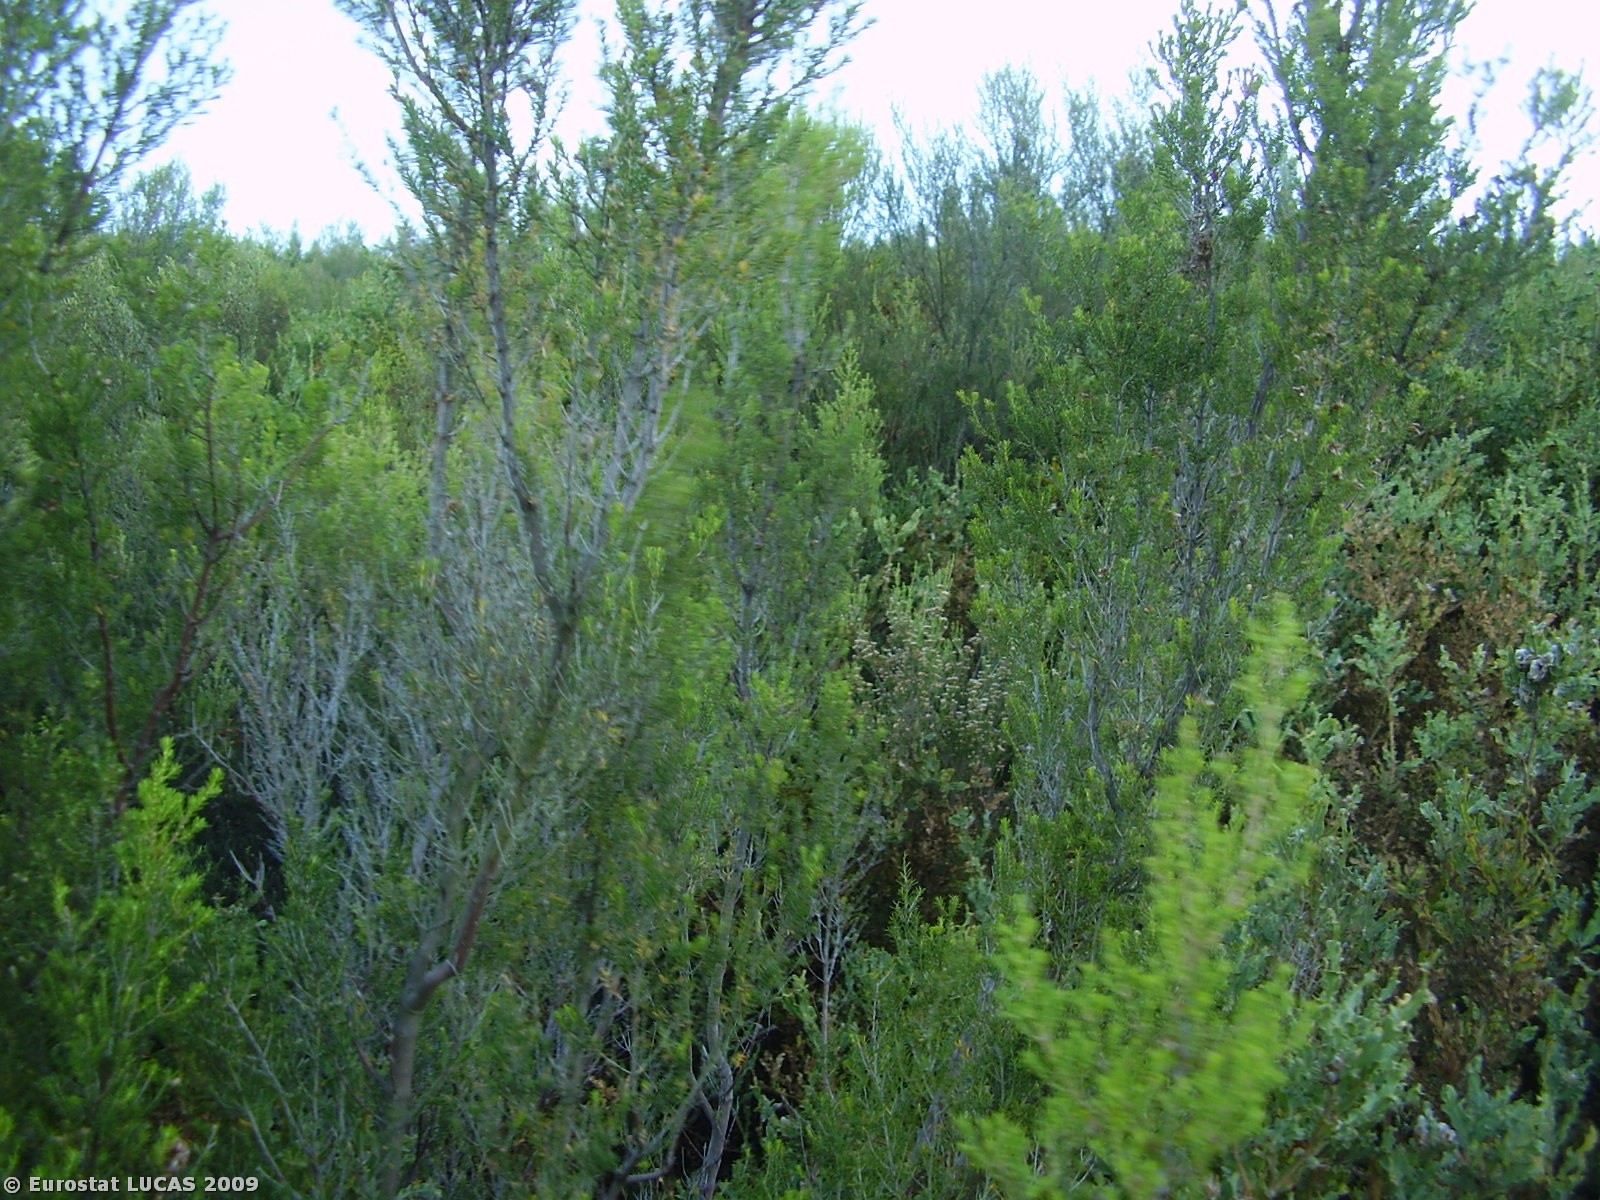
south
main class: Shrubland
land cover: Shrubland without tree cover
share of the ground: > 75 %
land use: Fallow land
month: September
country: PT
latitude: 41.7563
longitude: -7.6341
